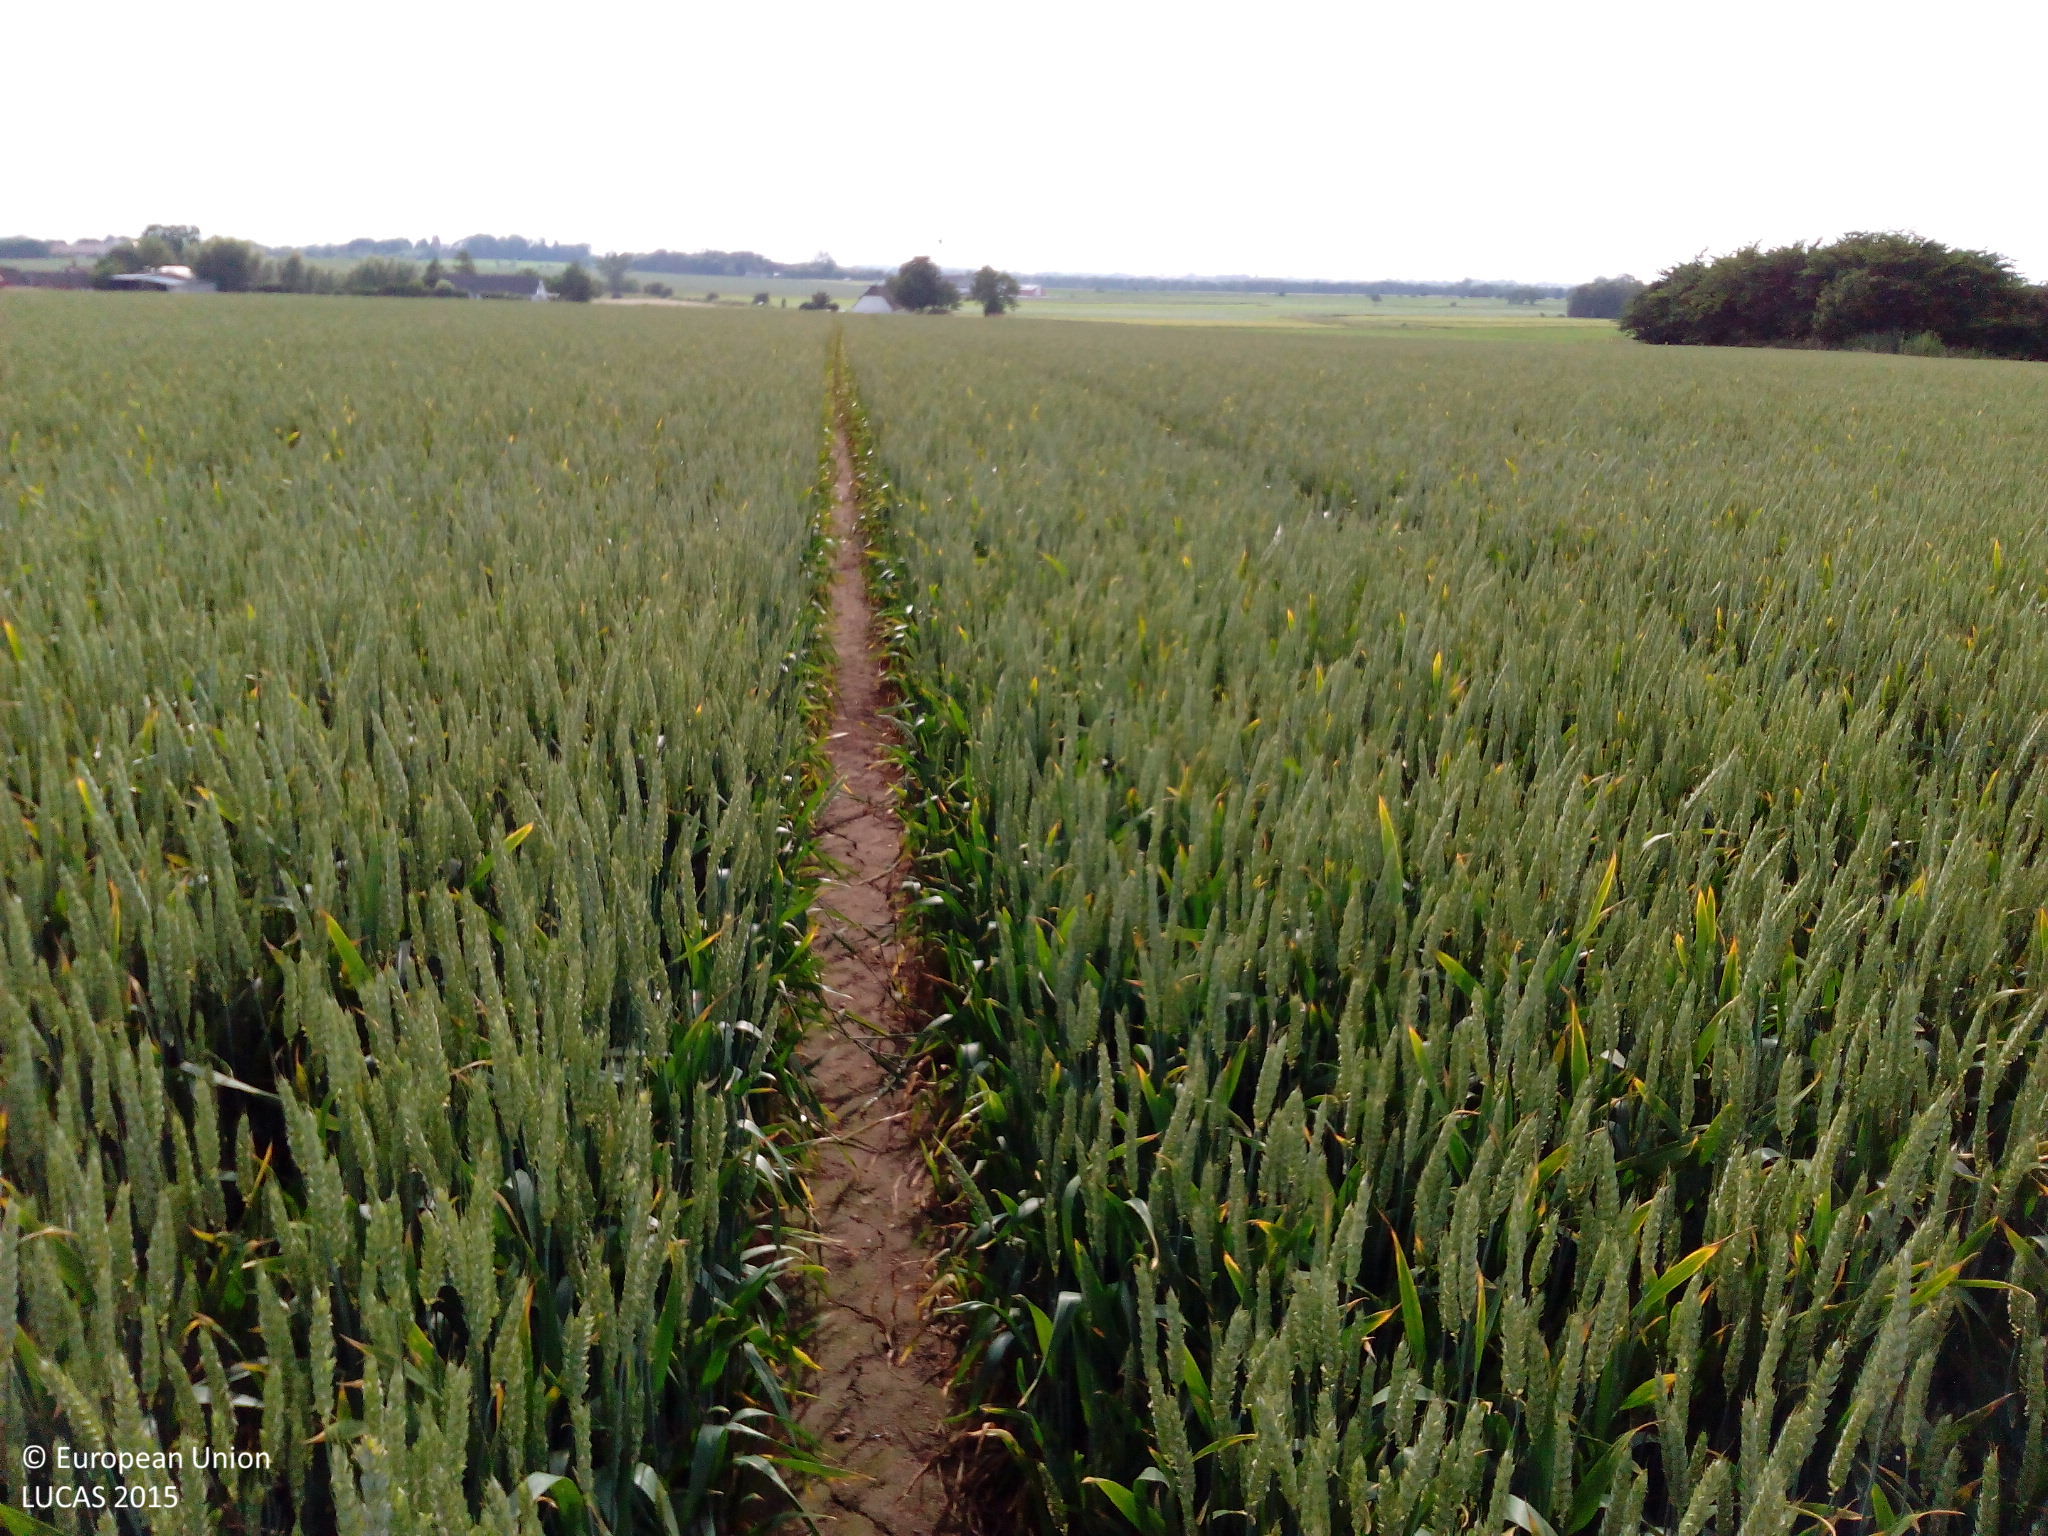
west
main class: Cropland
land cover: Common wheat
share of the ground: > 75 %
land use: Agriculture (excluding fallow land and kitchen gardens)
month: June
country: DK
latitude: 55.0950
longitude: 11.8947
